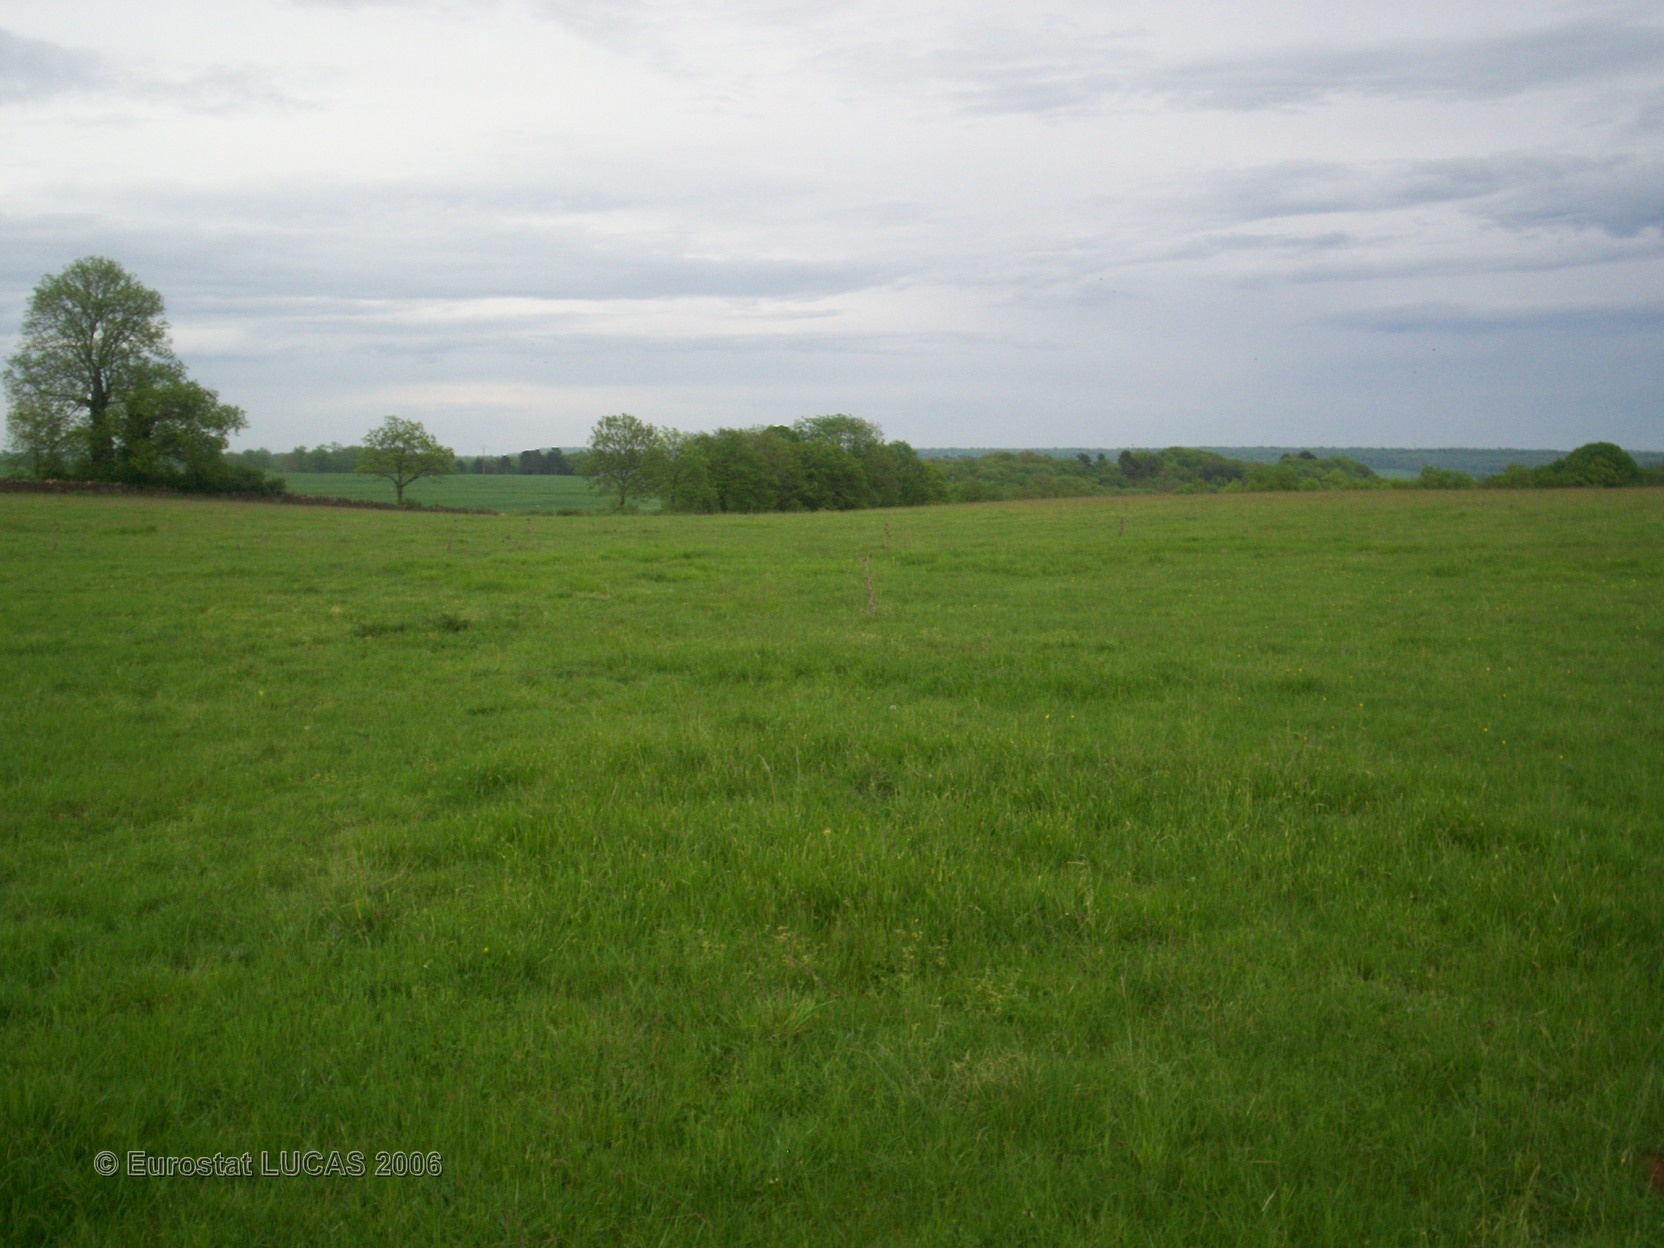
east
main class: Grassland
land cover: Grassland without tree/shrub cover
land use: Agriculture (excluding fallow land and kitchen gardens)
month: May
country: FR
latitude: 47.2805
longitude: 4.6191
